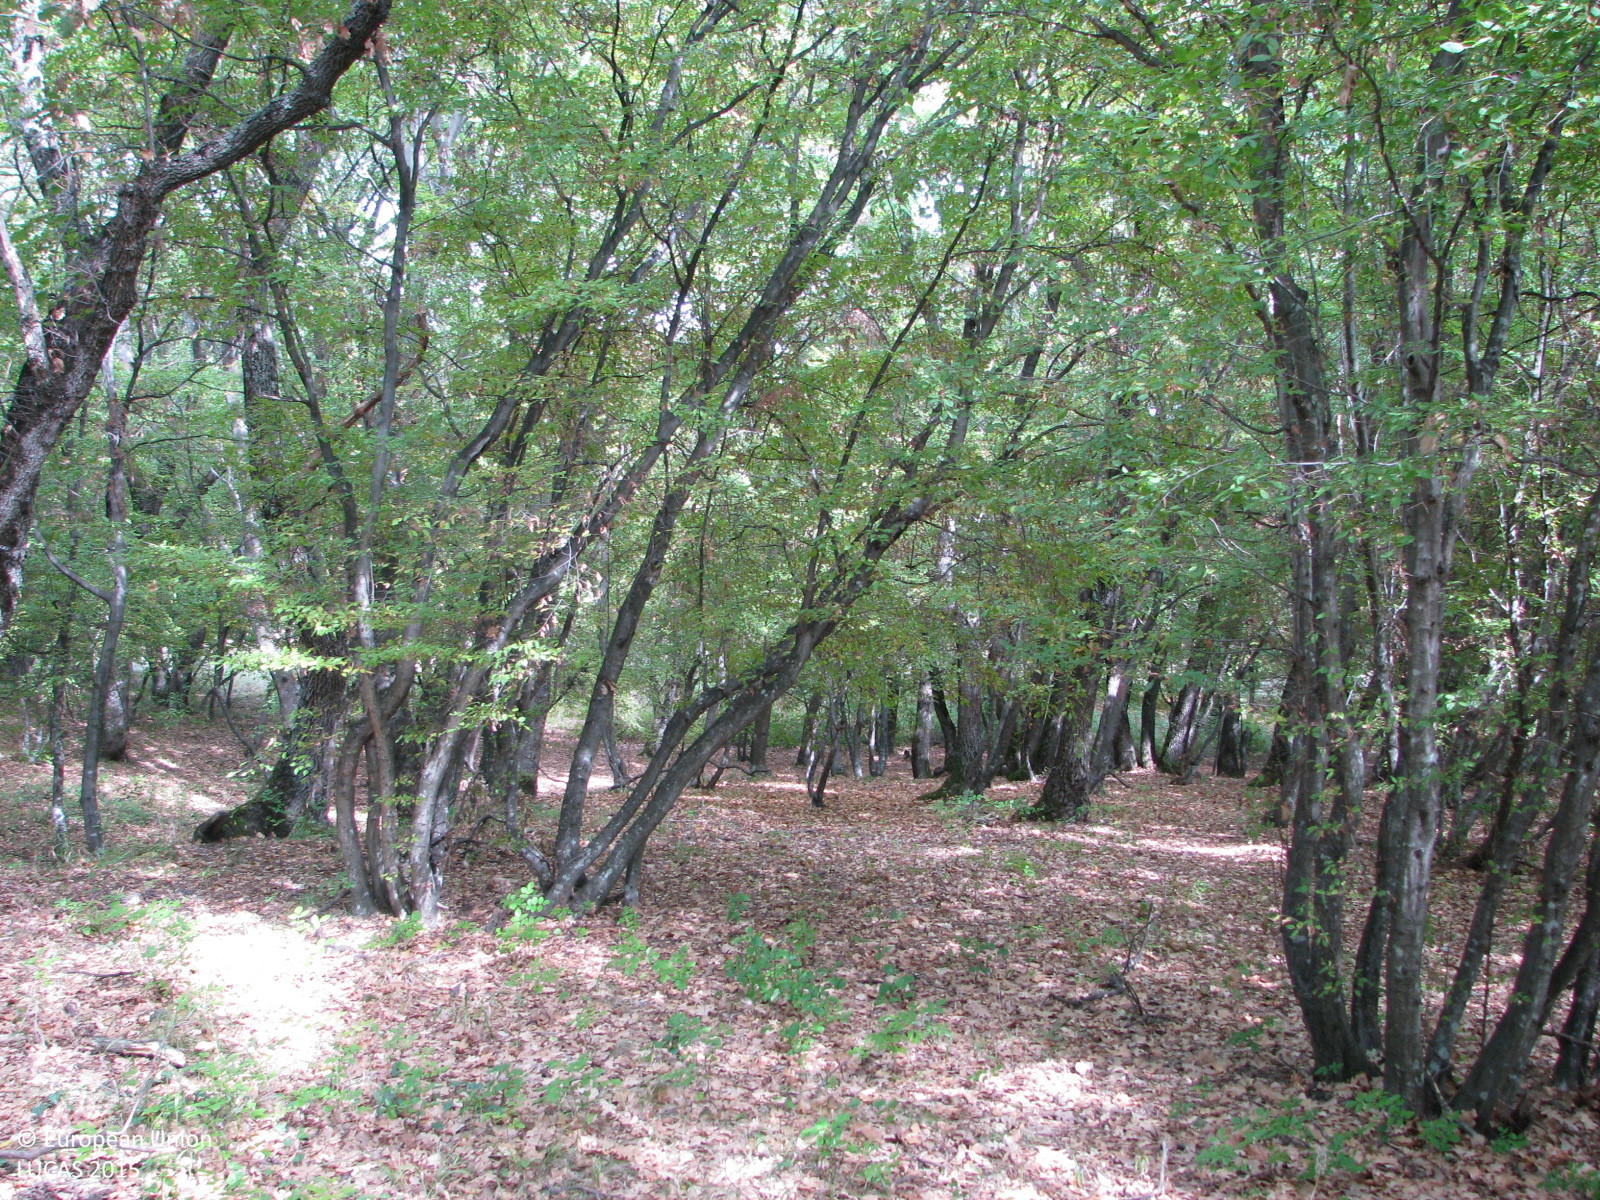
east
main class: Woodland
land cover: Broadleaved woodland
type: mesophytic deciduous forest
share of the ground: 50 - 75 %
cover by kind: broadleaved forest trees 70 %, unconsolidated bare surface 30 %
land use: Forestry
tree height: > 5 m
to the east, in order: Broadleaved woodland; Grass margins; Tracks; Grassland with sparse tree/shrub cover; Tracks; Broadleaved woodland; Grassland with sparse tree/shrub cover
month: October
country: BG
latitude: 42.5425
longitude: 25.9216
